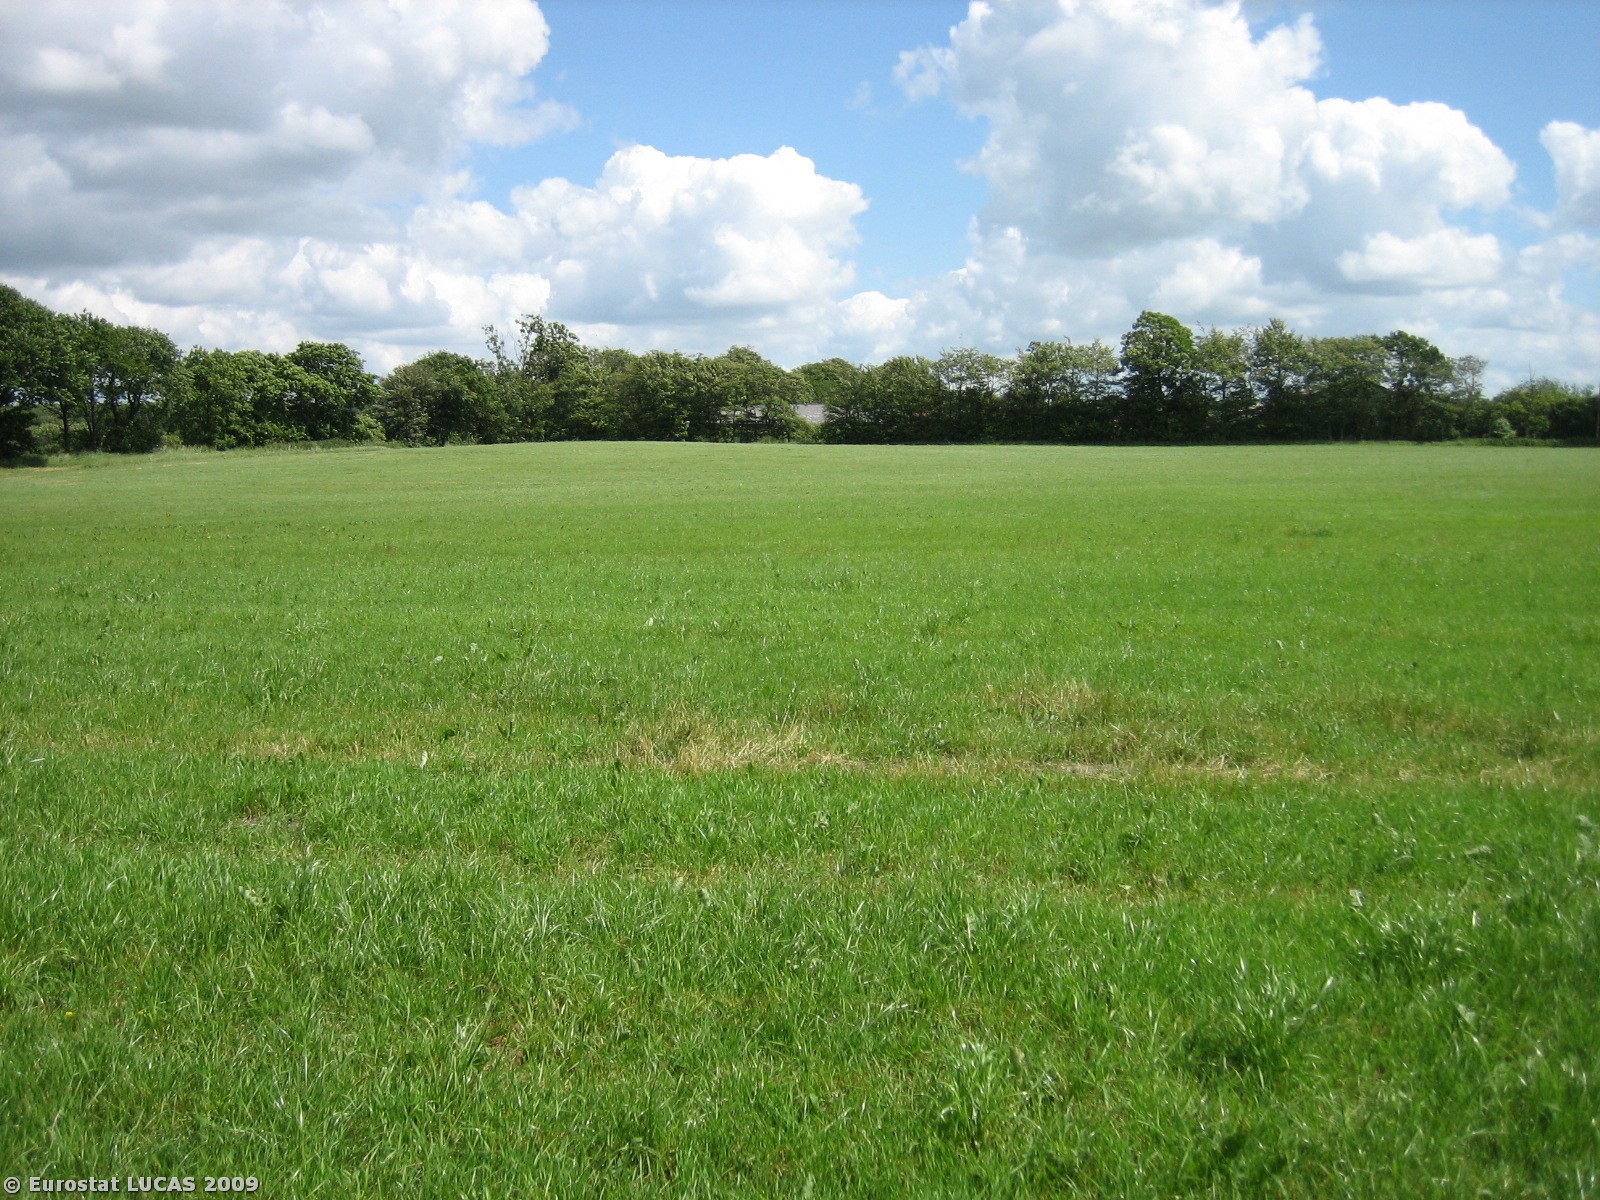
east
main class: Cropland
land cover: Temporary grasslands
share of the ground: > 75 %
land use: Agriculture (excluding fallow land and kitchen gardens)
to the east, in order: Temporary grasslands; Broadleaved woodland; Grassland without tree/shrub cover; Tracks; Grassland with sparse tree/shrub cover; Artificial constructions in urban areas; Grassland with sparse tree/shrub cover
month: June
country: DK
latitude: 55.7719
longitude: 9.2197
